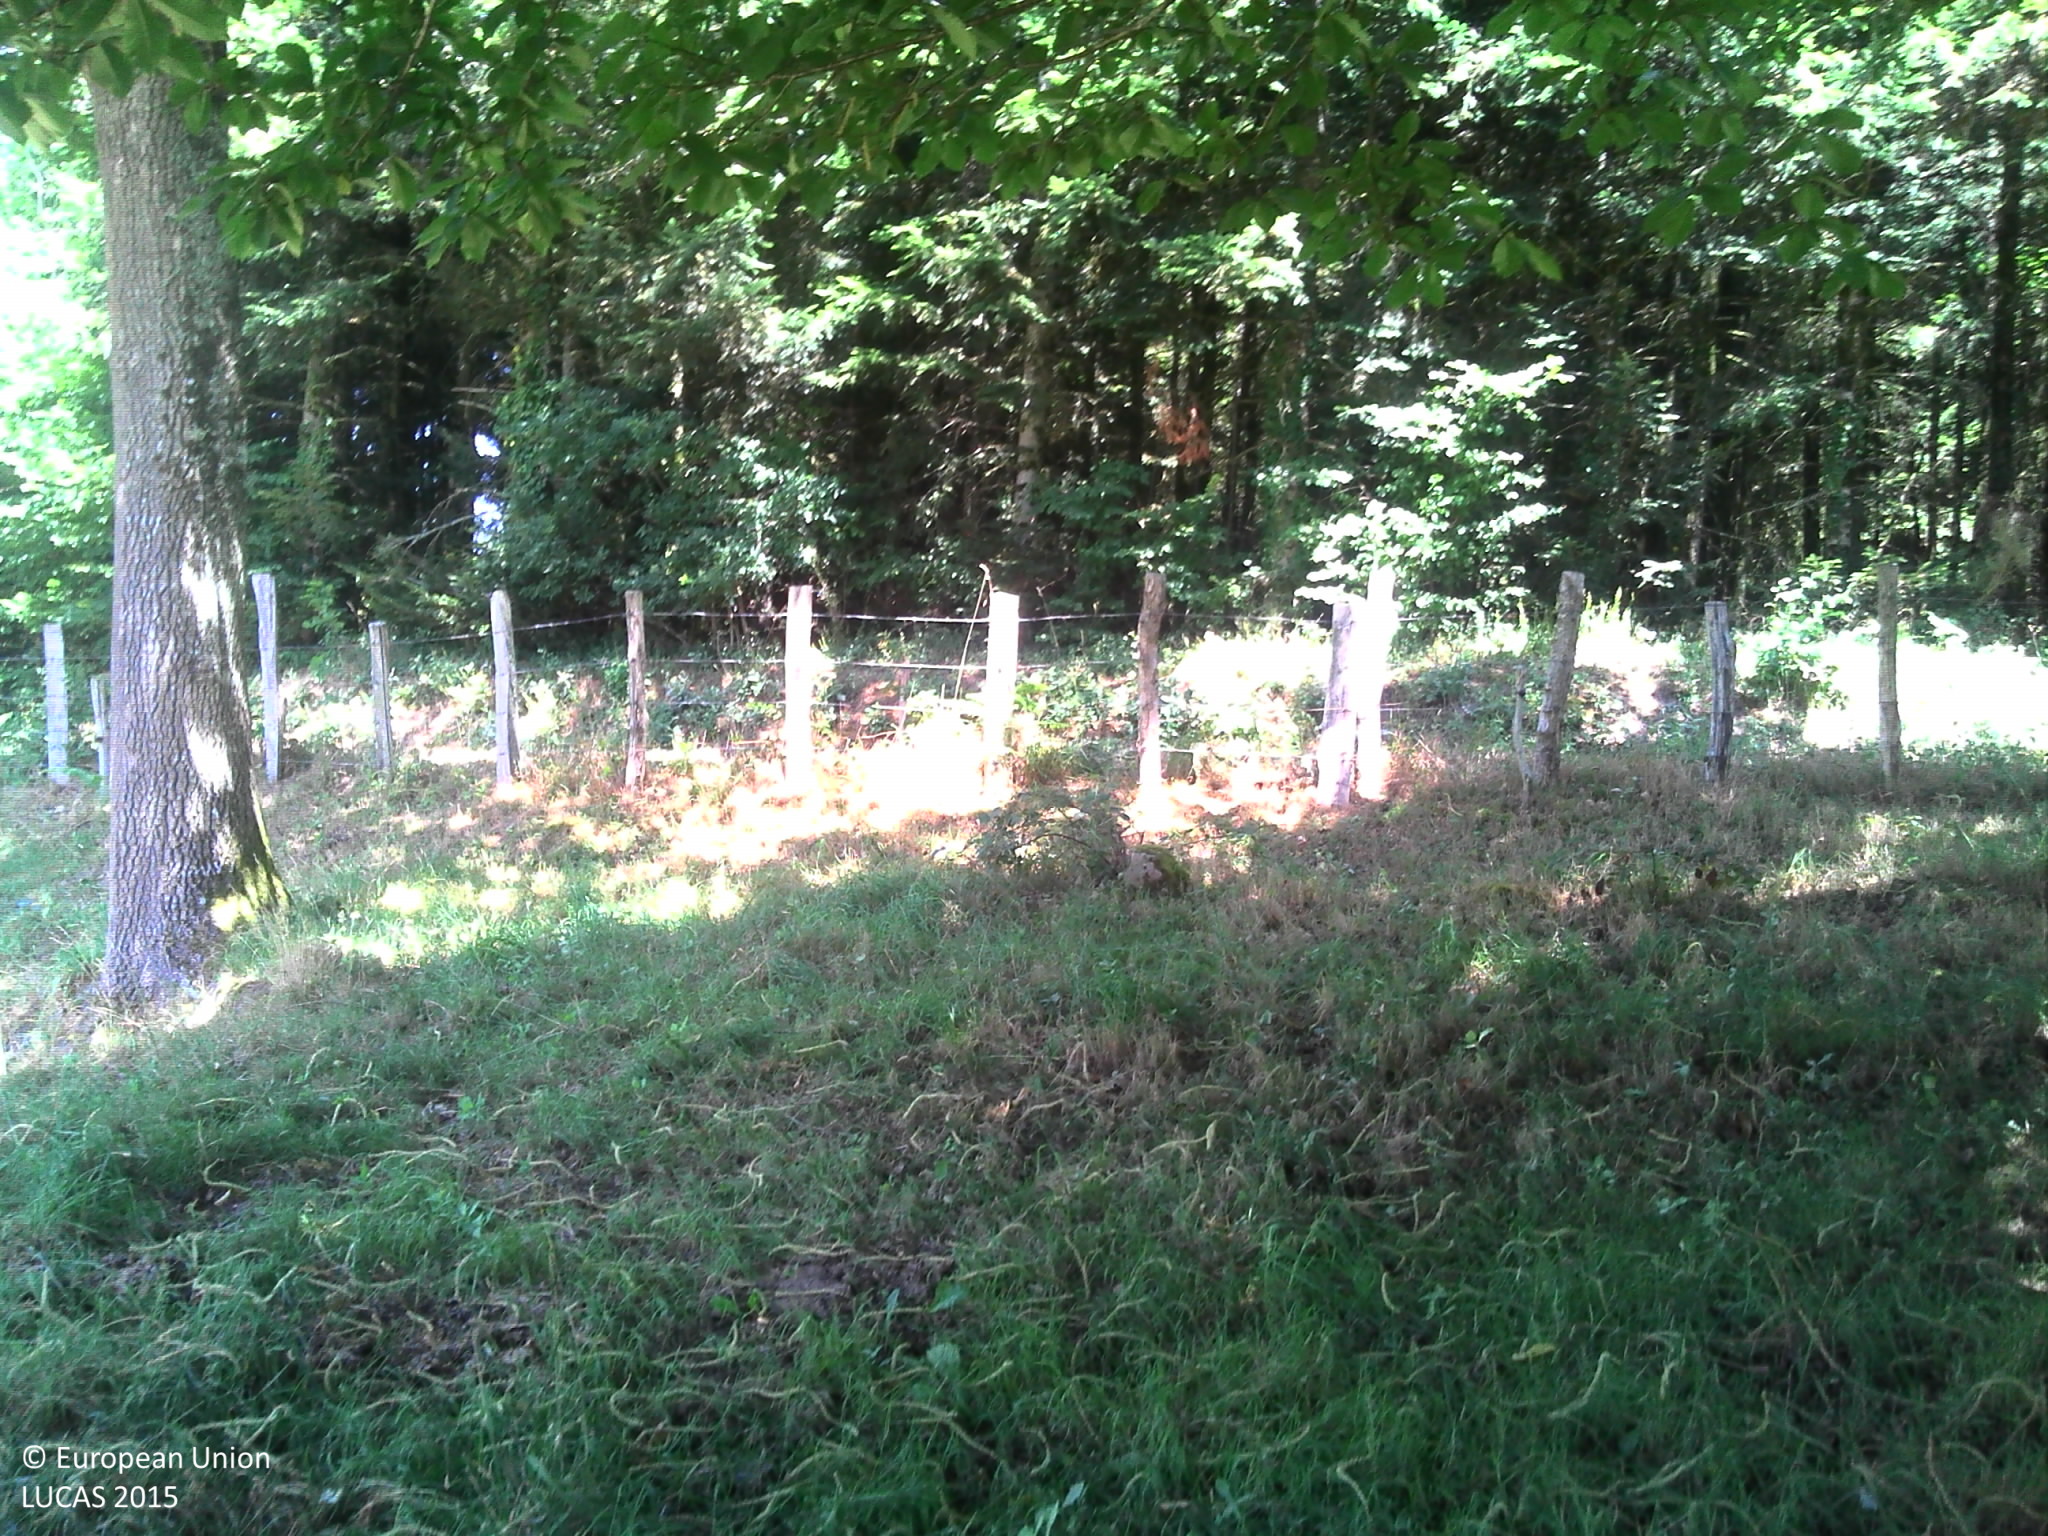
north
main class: Woodland
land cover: Broadleaved woodland
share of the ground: > 75 %
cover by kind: broadleaved forest trees 65 %, herbaceous plants 35 %
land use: Agriculture (excluding fallow land and kitchen gardens)
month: July
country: FR
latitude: 46.2039
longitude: 1.6323
